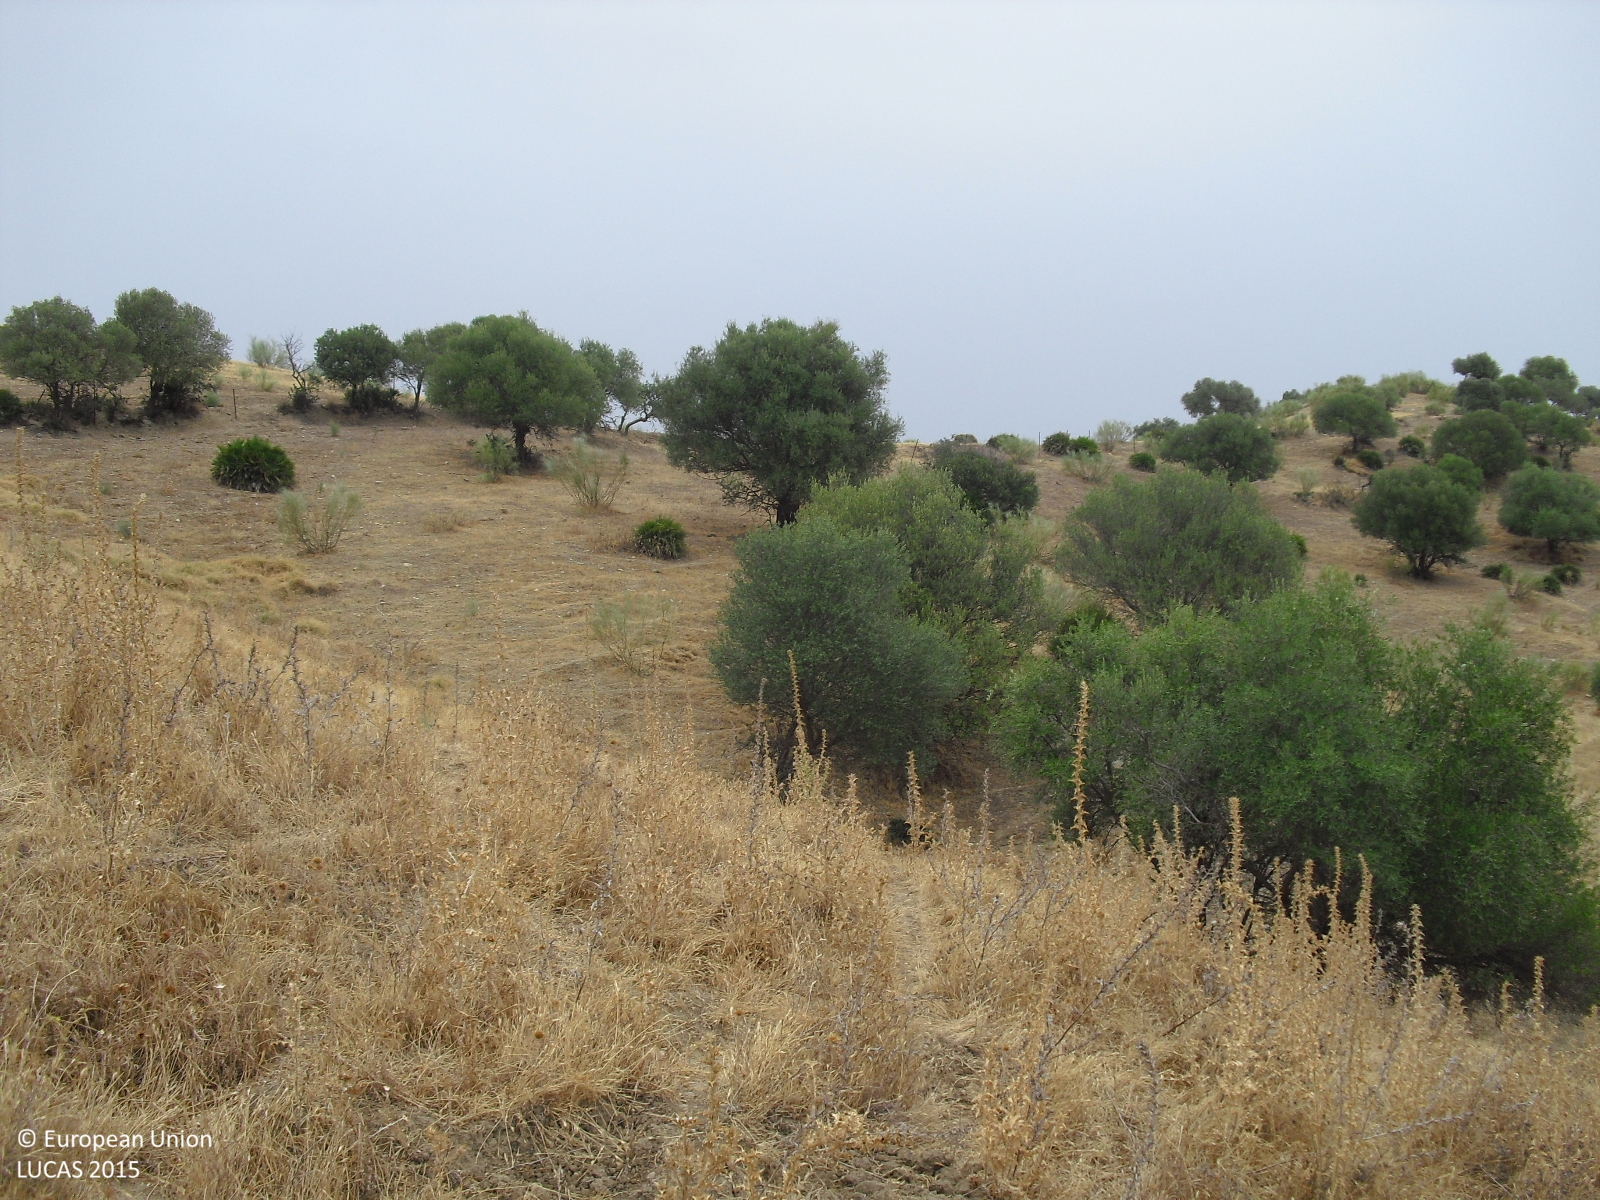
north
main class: Grassland
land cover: Grassland without tree/shrub cover
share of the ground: > 75 %
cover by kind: herbaceous plants 95 %, unconsolidated bare surface 5 %
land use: Agriculture (excluding fallow land and kitchen gardens)
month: August
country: ES
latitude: 37.1410
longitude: -5.3308
